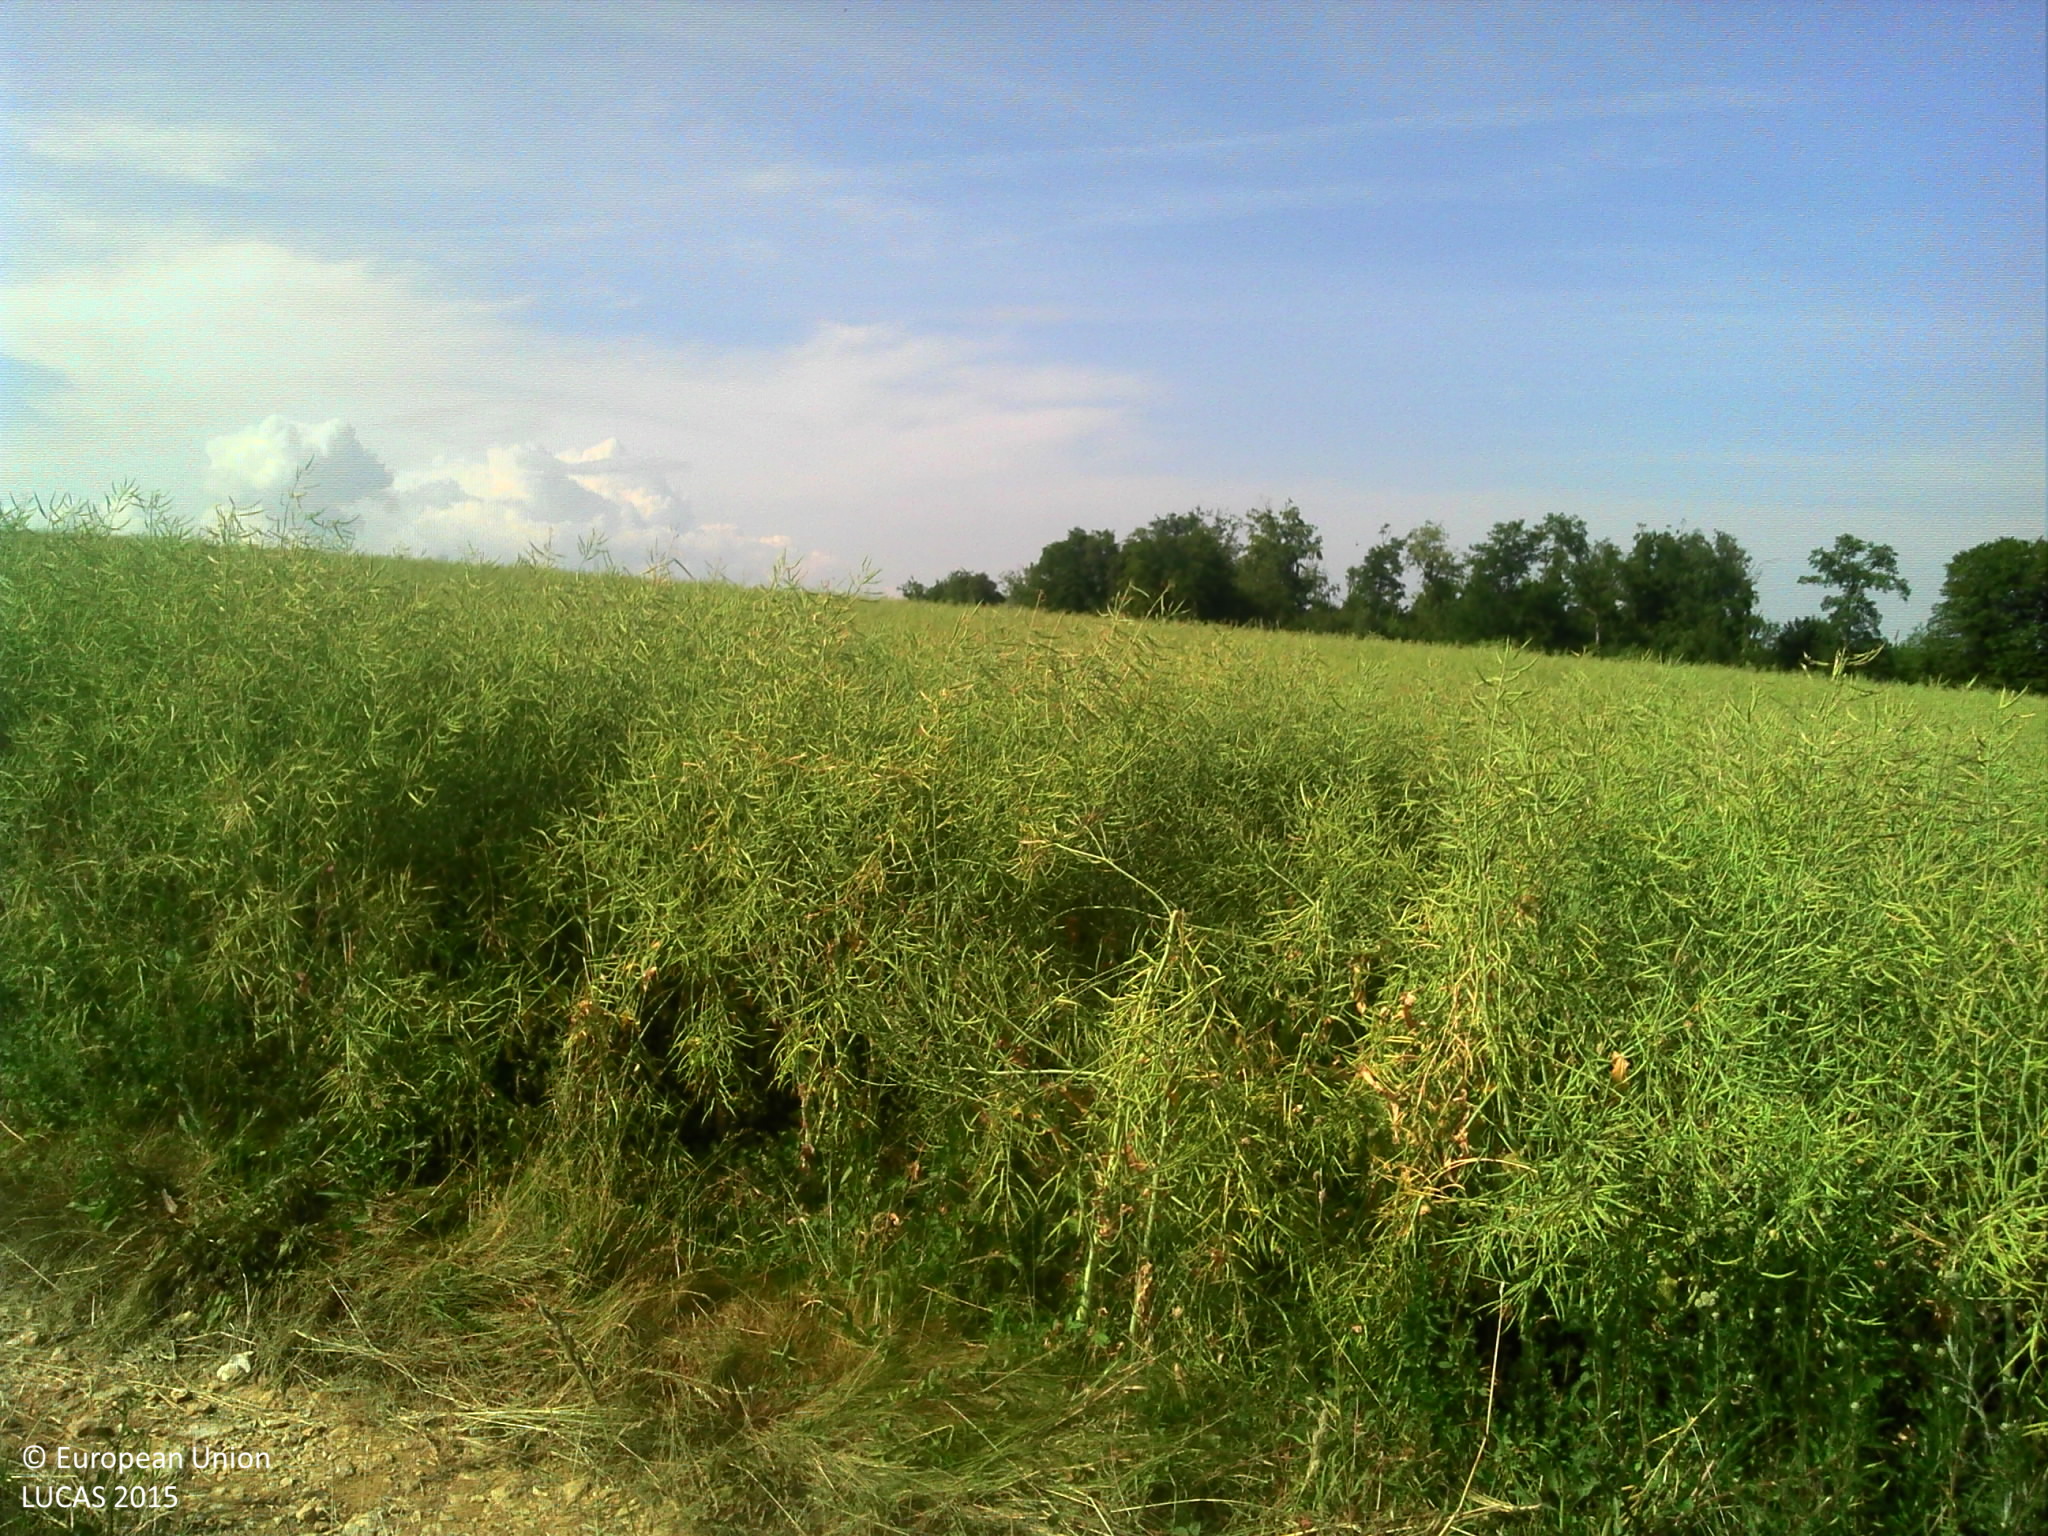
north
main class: Cropland
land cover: Rape and turnip rape
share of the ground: > 75 %
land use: Agriculture (excluding fallow land and kitchen gardens)
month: June
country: FR
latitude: 48.3034
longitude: 4.8889
